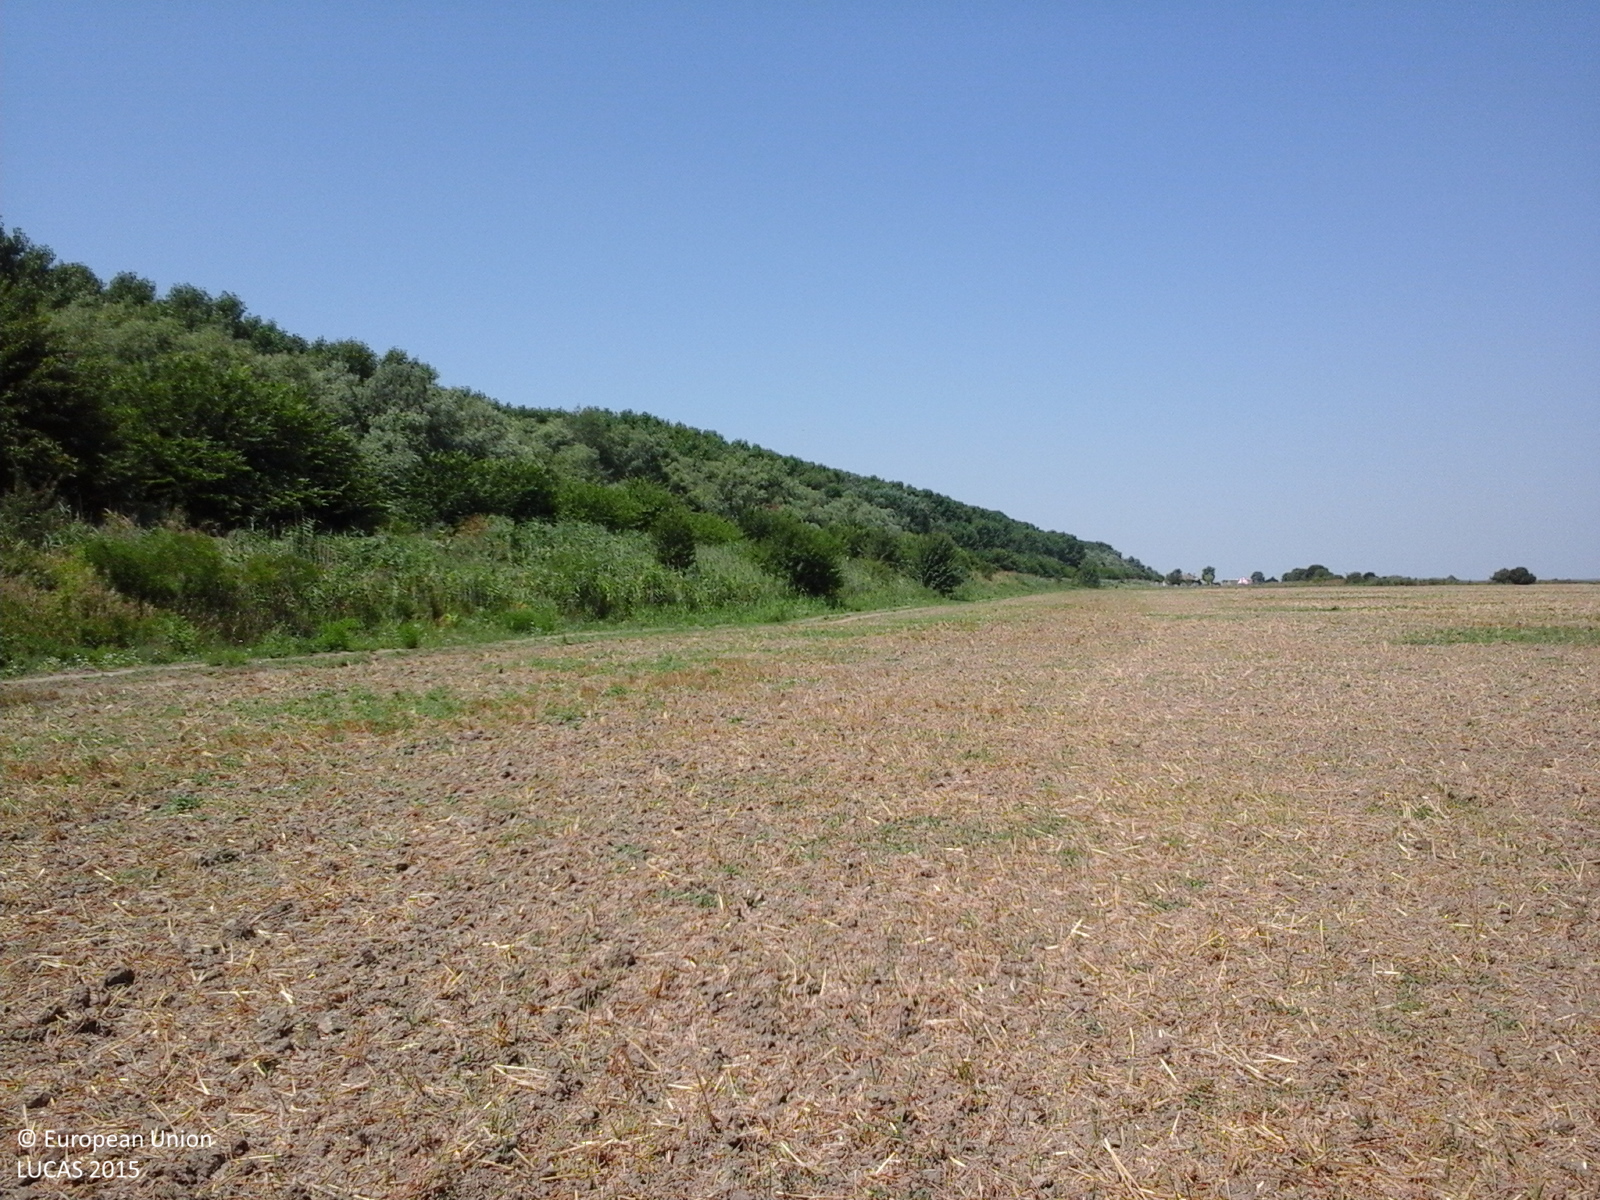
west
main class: Cropland
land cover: Durum wheat
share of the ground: < 10 %
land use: Agriculture (excluding fallow land and kitchen gardens)
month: July
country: RO
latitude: 44.2581
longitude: 27.8745
